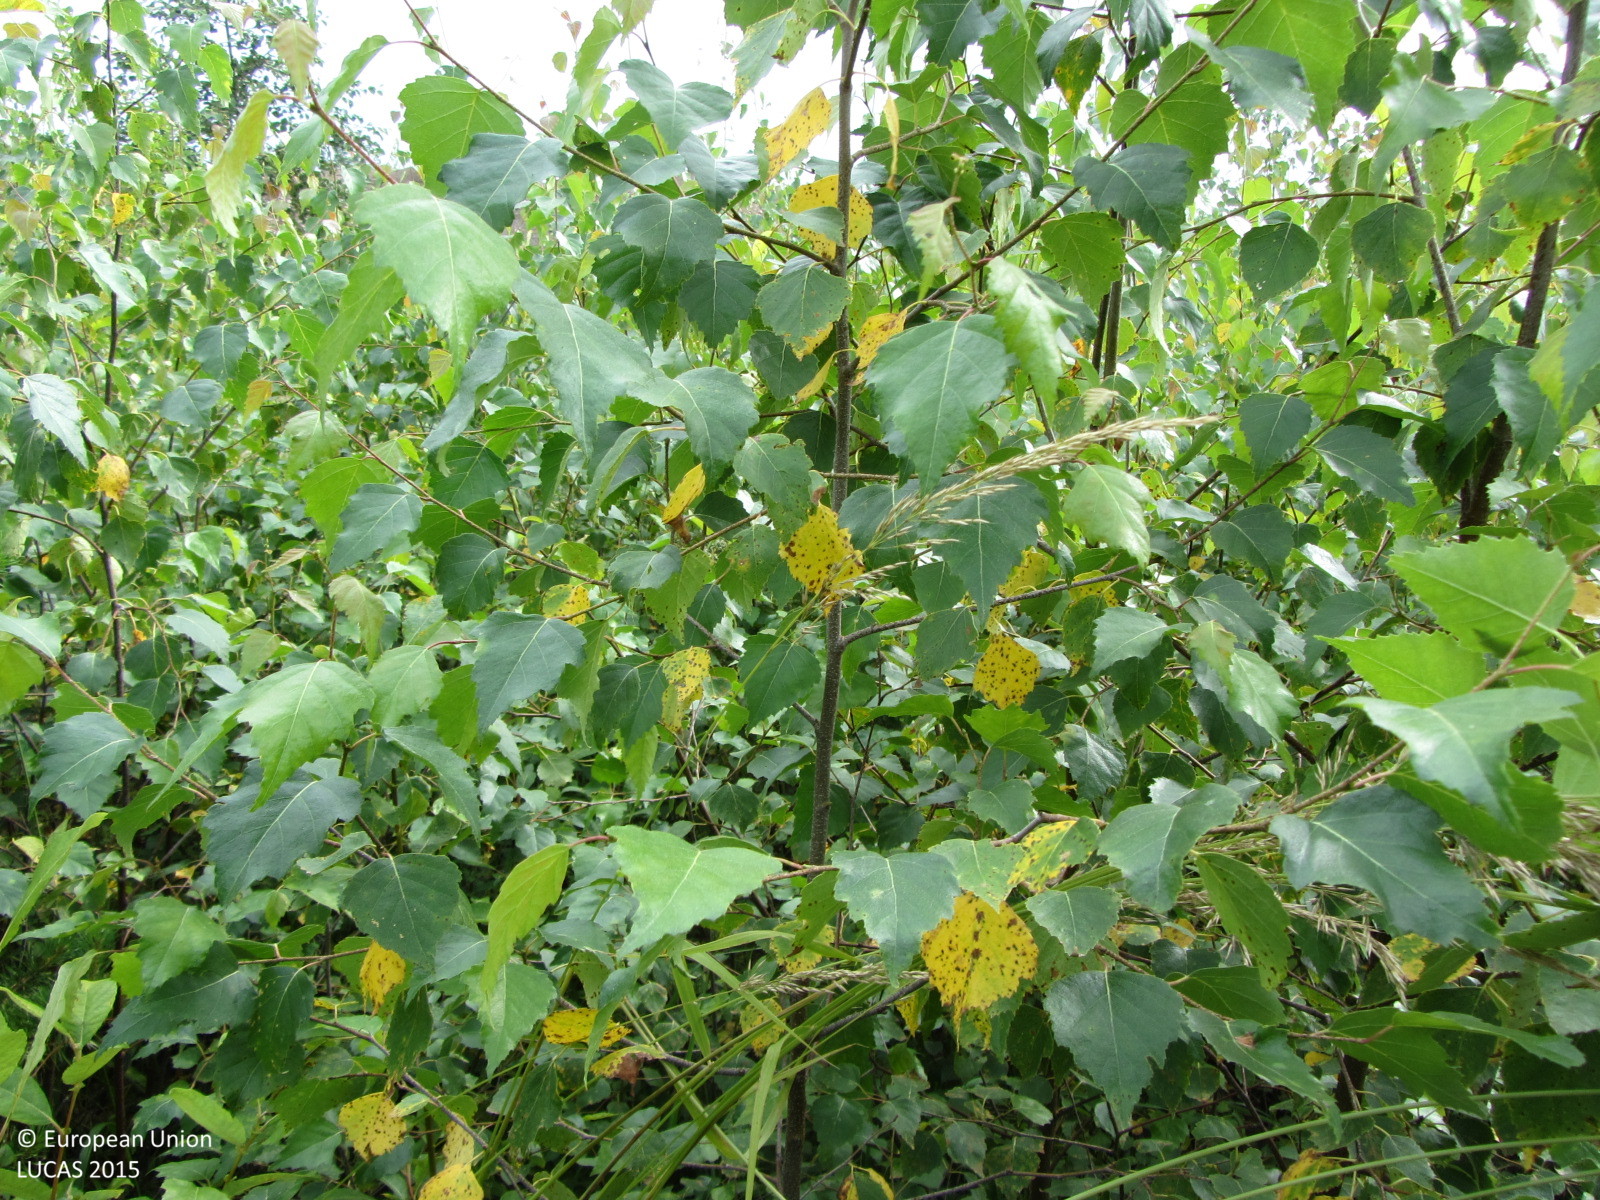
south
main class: Woodland
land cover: Pine dominated mixed woodland
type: boreal forest
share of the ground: > 75 %
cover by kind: broadleaved forest trees 55 %, coniferous forest trees 45 %
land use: Forestry
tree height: < 5 m
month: July
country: FI
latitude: 60.5148
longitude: 24.4392
